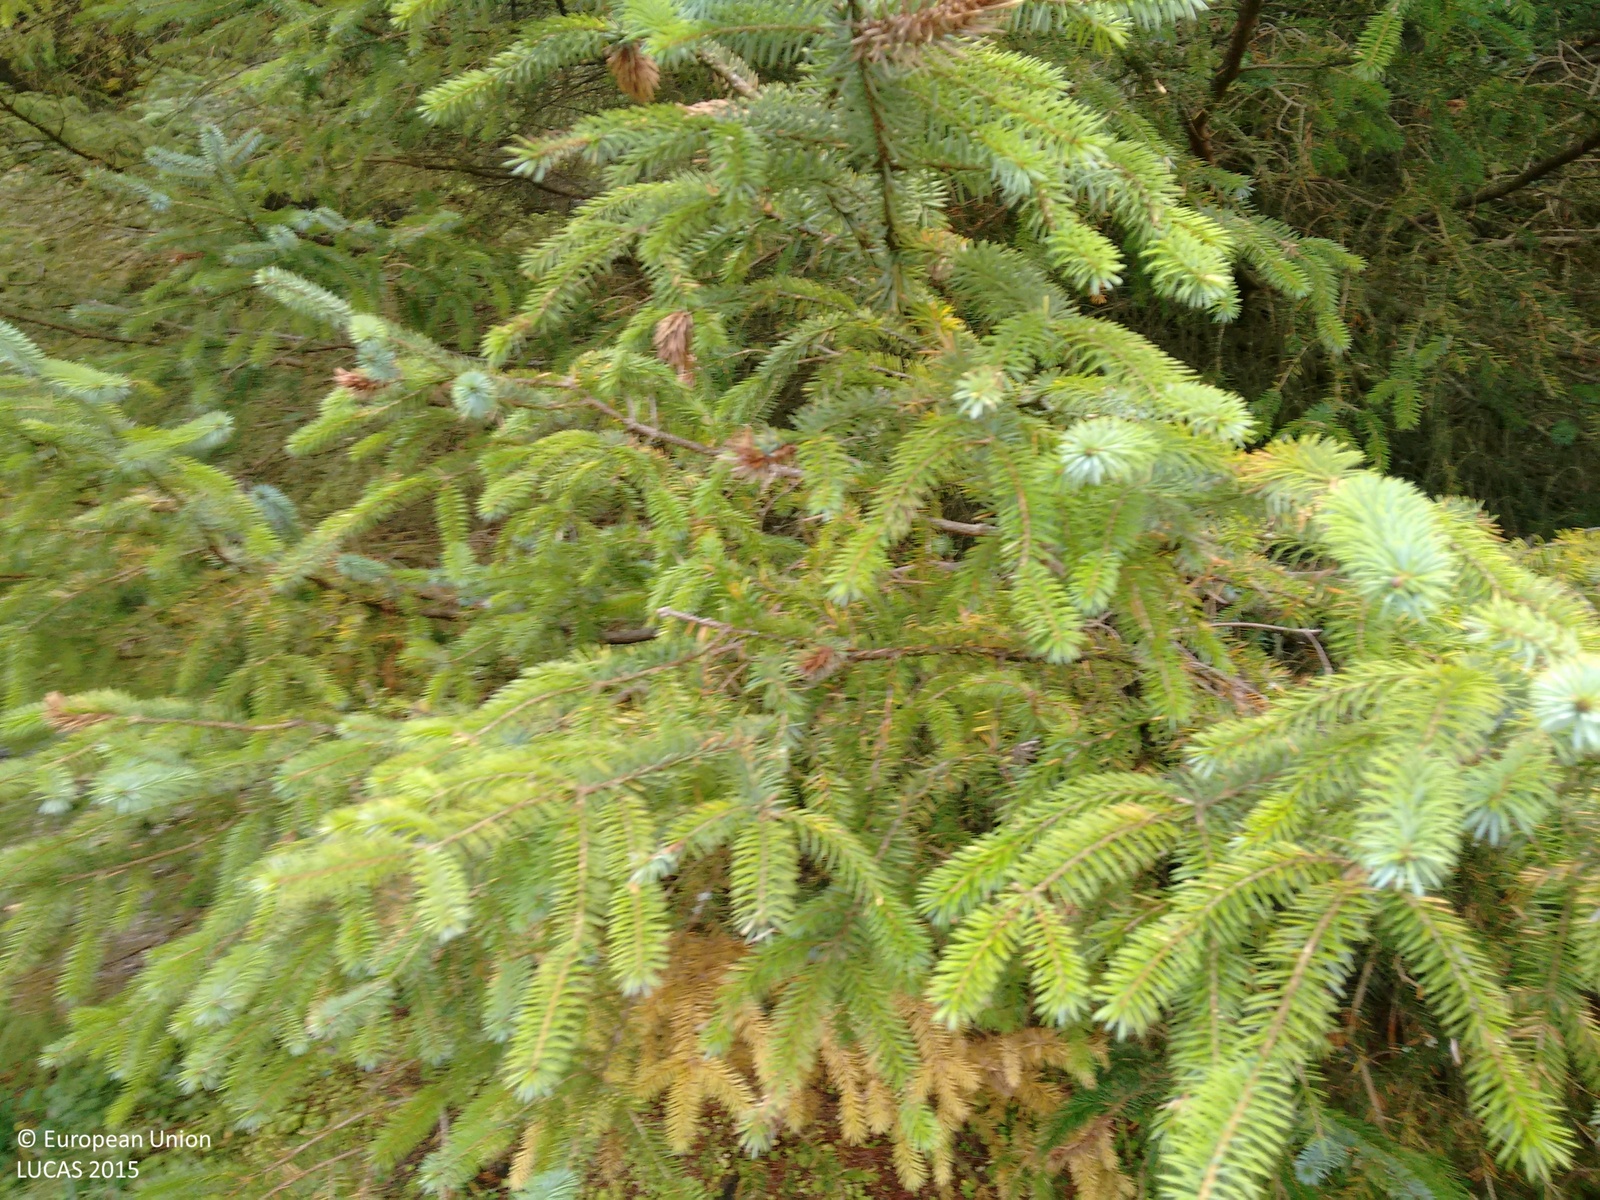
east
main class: Woodland
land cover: Spruce dominated coniferous woodland
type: exotic forest
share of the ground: > 75 %
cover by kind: coniferous forest trees 95 %, lichens and mosses 5 %
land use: Forestry
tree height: > 5 m
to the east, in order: Spruce dominated coniferous woodland; Grassland without tree/shrub cover
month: September
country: GB
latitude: 55.4419
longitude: -3.7578
